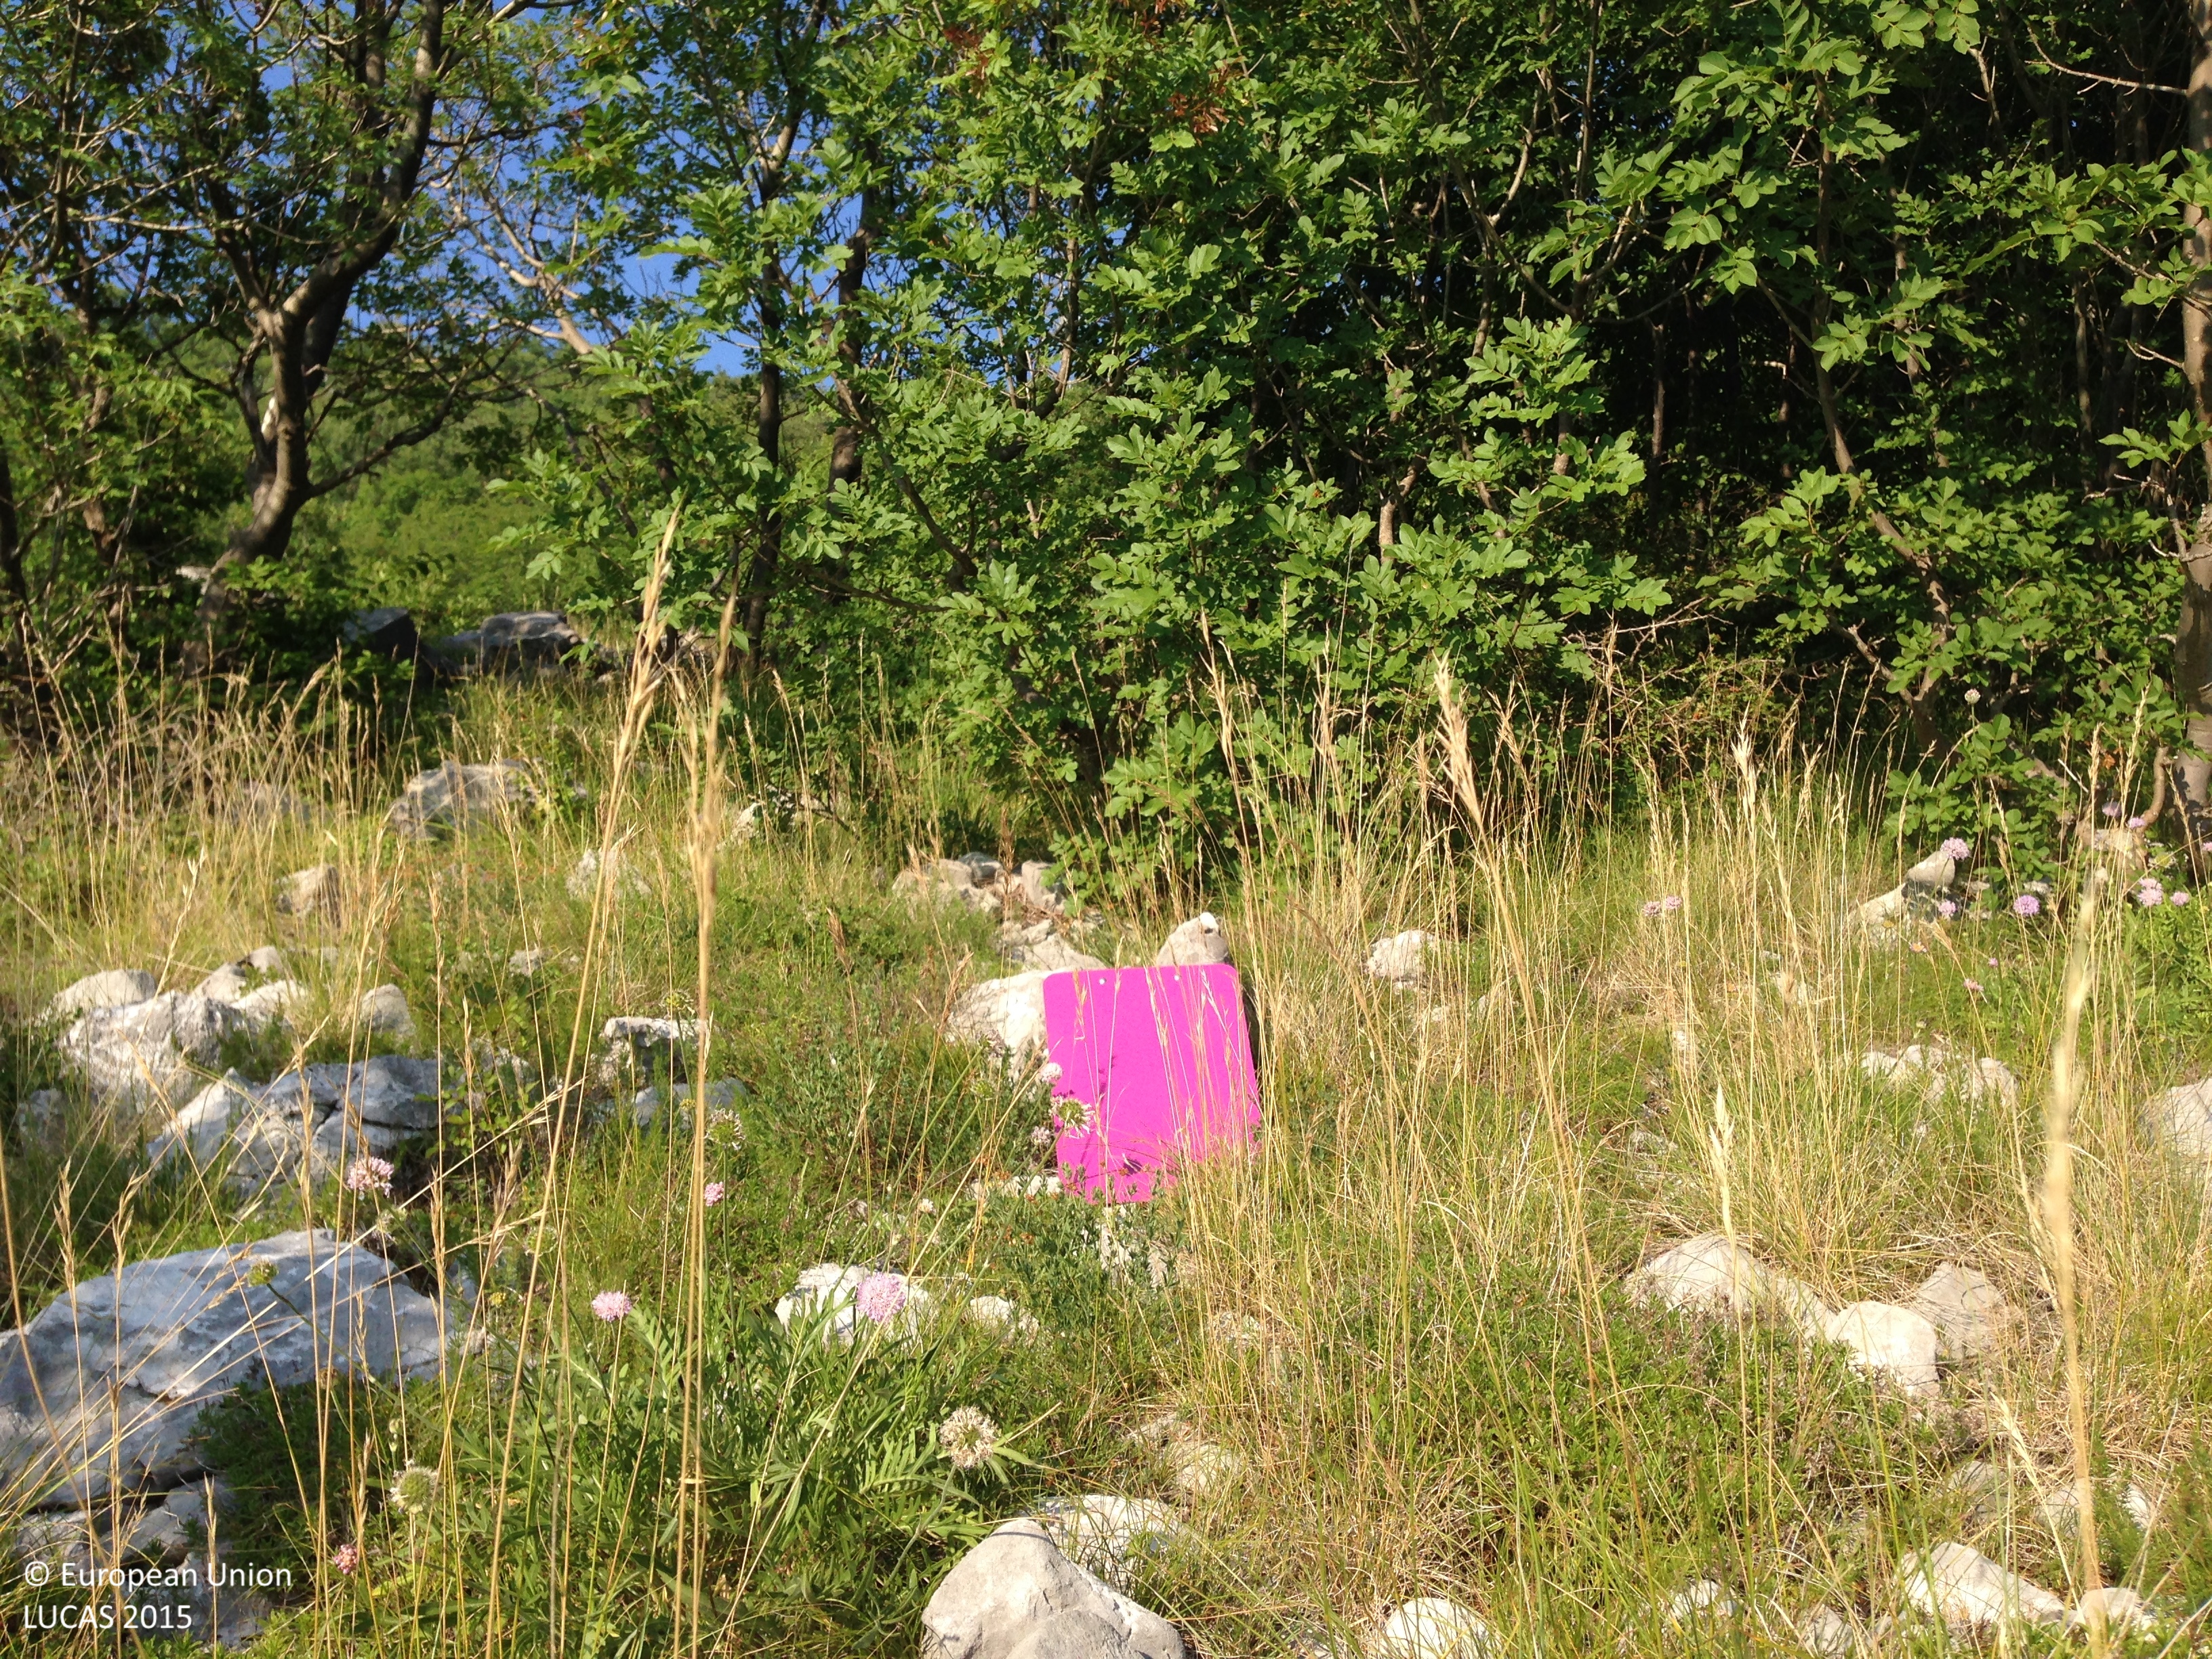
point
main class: Woodland
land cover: Broadleaved woodland
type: thermophilous deciduous forest
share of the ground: > 75 %
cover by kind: broadleaved forest trees 35 %, herbaceous plants 30 %, consolidated bare surface 15 %, shrubs 10 %, unconsolidated bare surface 10 %
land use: Forestry
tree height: < 5 m
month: July
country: HR
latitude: 44.5316
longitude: 15.1148
